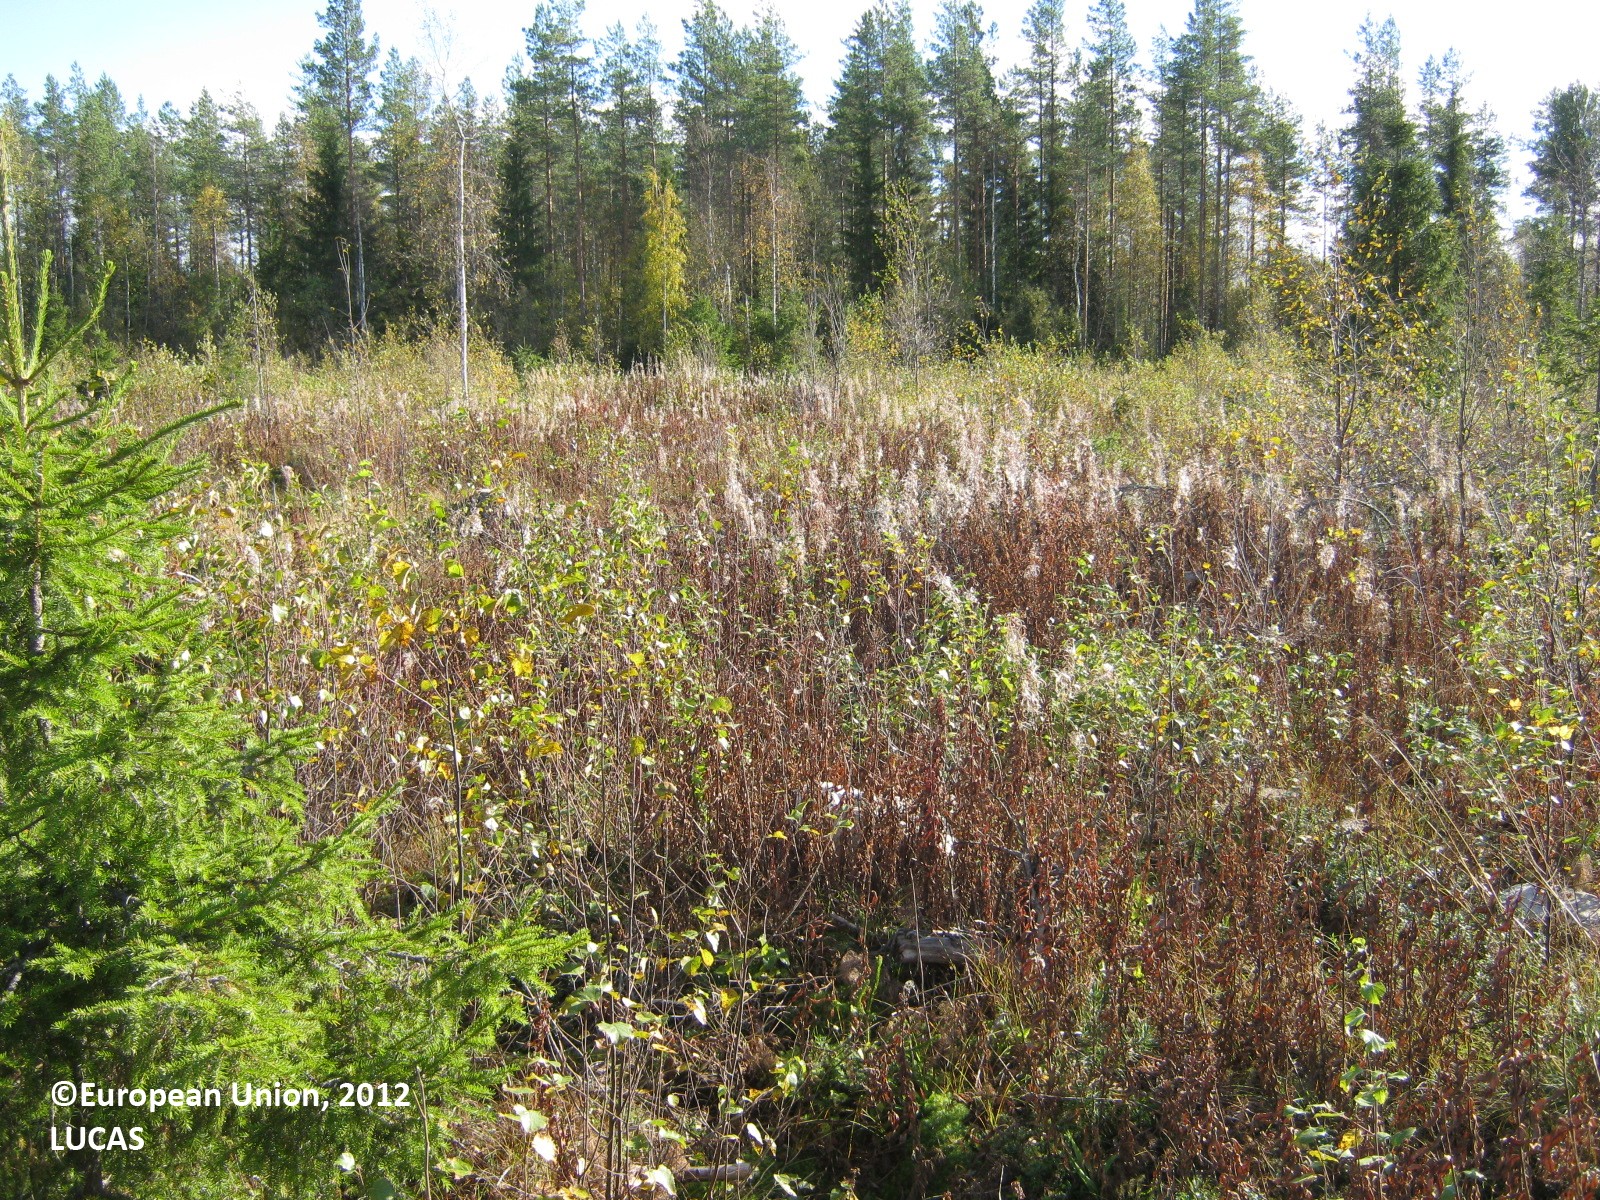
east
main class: Woodland
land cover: Broadleaved woodland
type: boreal forest
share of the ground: > 75 %
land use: Forestry
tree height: < 5 m
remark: Clear cut
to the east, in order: Broadleaved woodland; Pine dominated mixed woodland; Ditches and canals; Pine dominated mixed woodland; Ditches and canals; Pine dominated mixed woodland; Ditches and canals; Pine dominated mixed woodland; Ditches and canals; Other mixed woodland
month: September
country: FI
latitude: 63.4285
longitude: 25.8400
